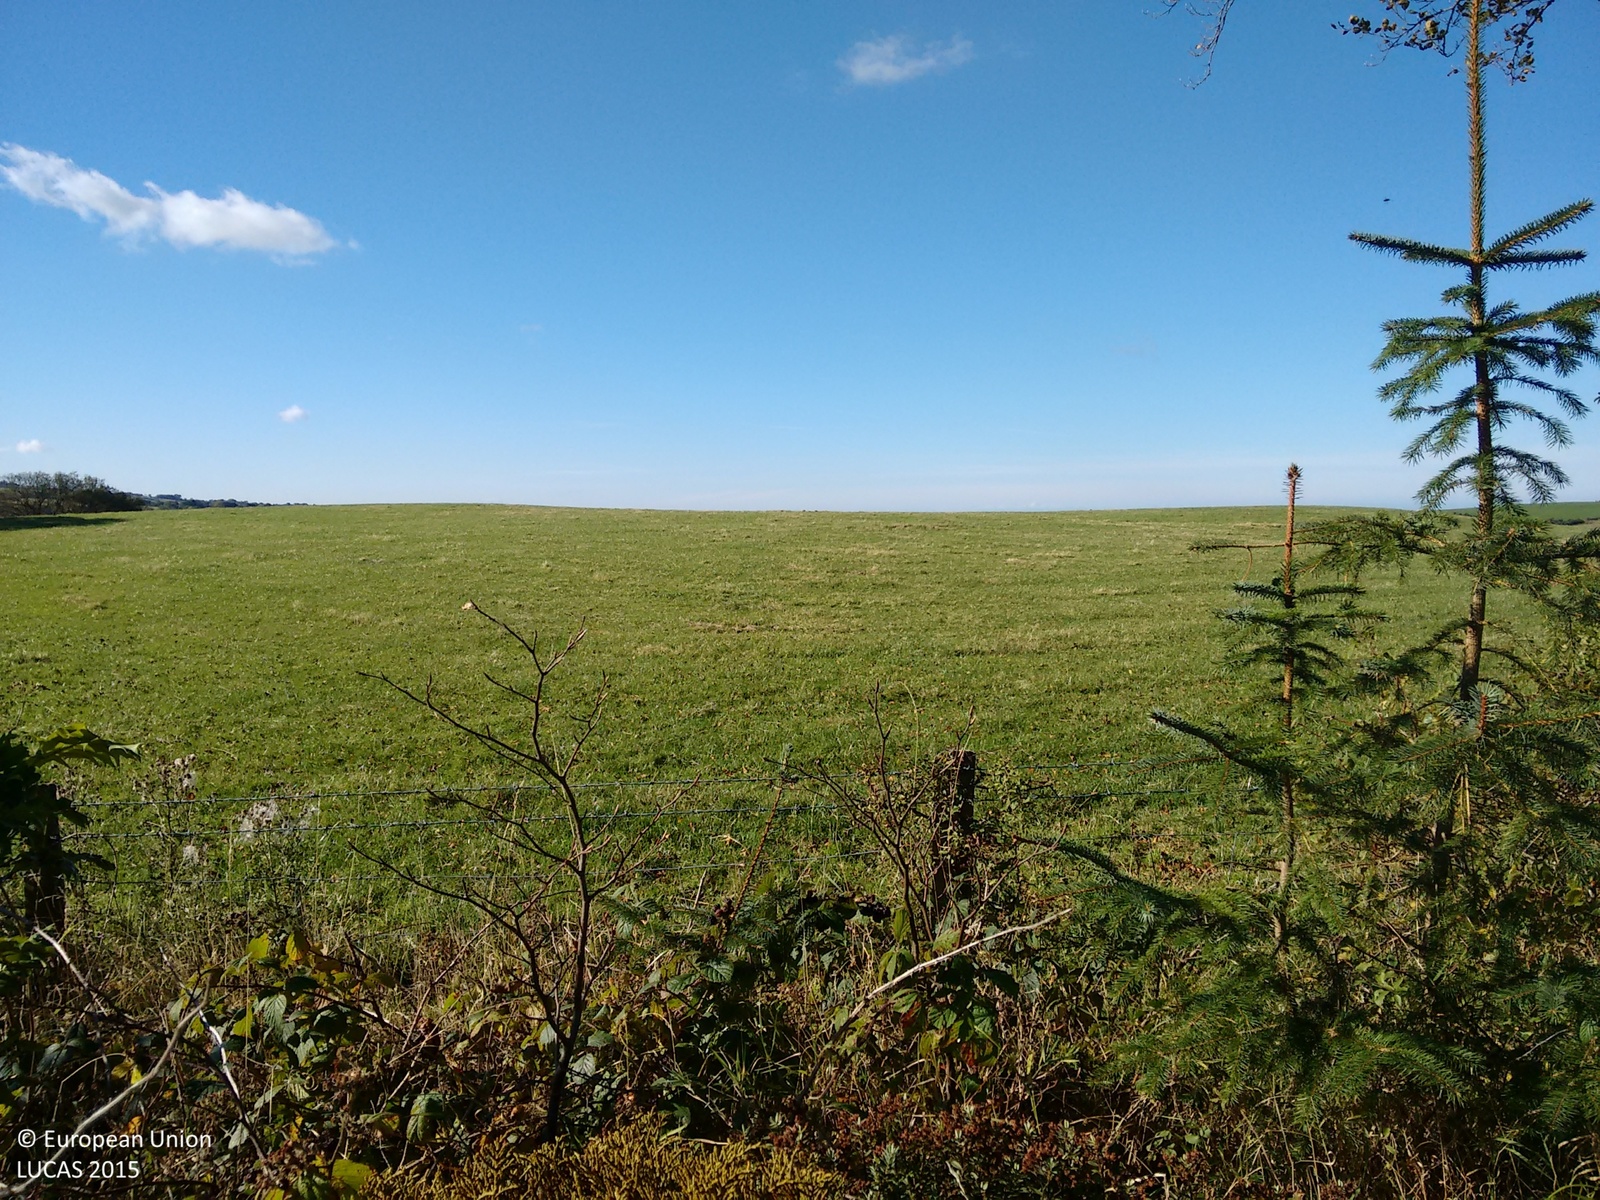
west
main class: Grassland
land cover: Grassland without tree/shrub cover
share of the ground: > 75 %
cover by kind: herbaceous plants 100 %
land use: Agriculture (excluding fallow land and kitchen gardens)
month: October
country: GB
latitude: 52.3252
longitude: -4.0192
